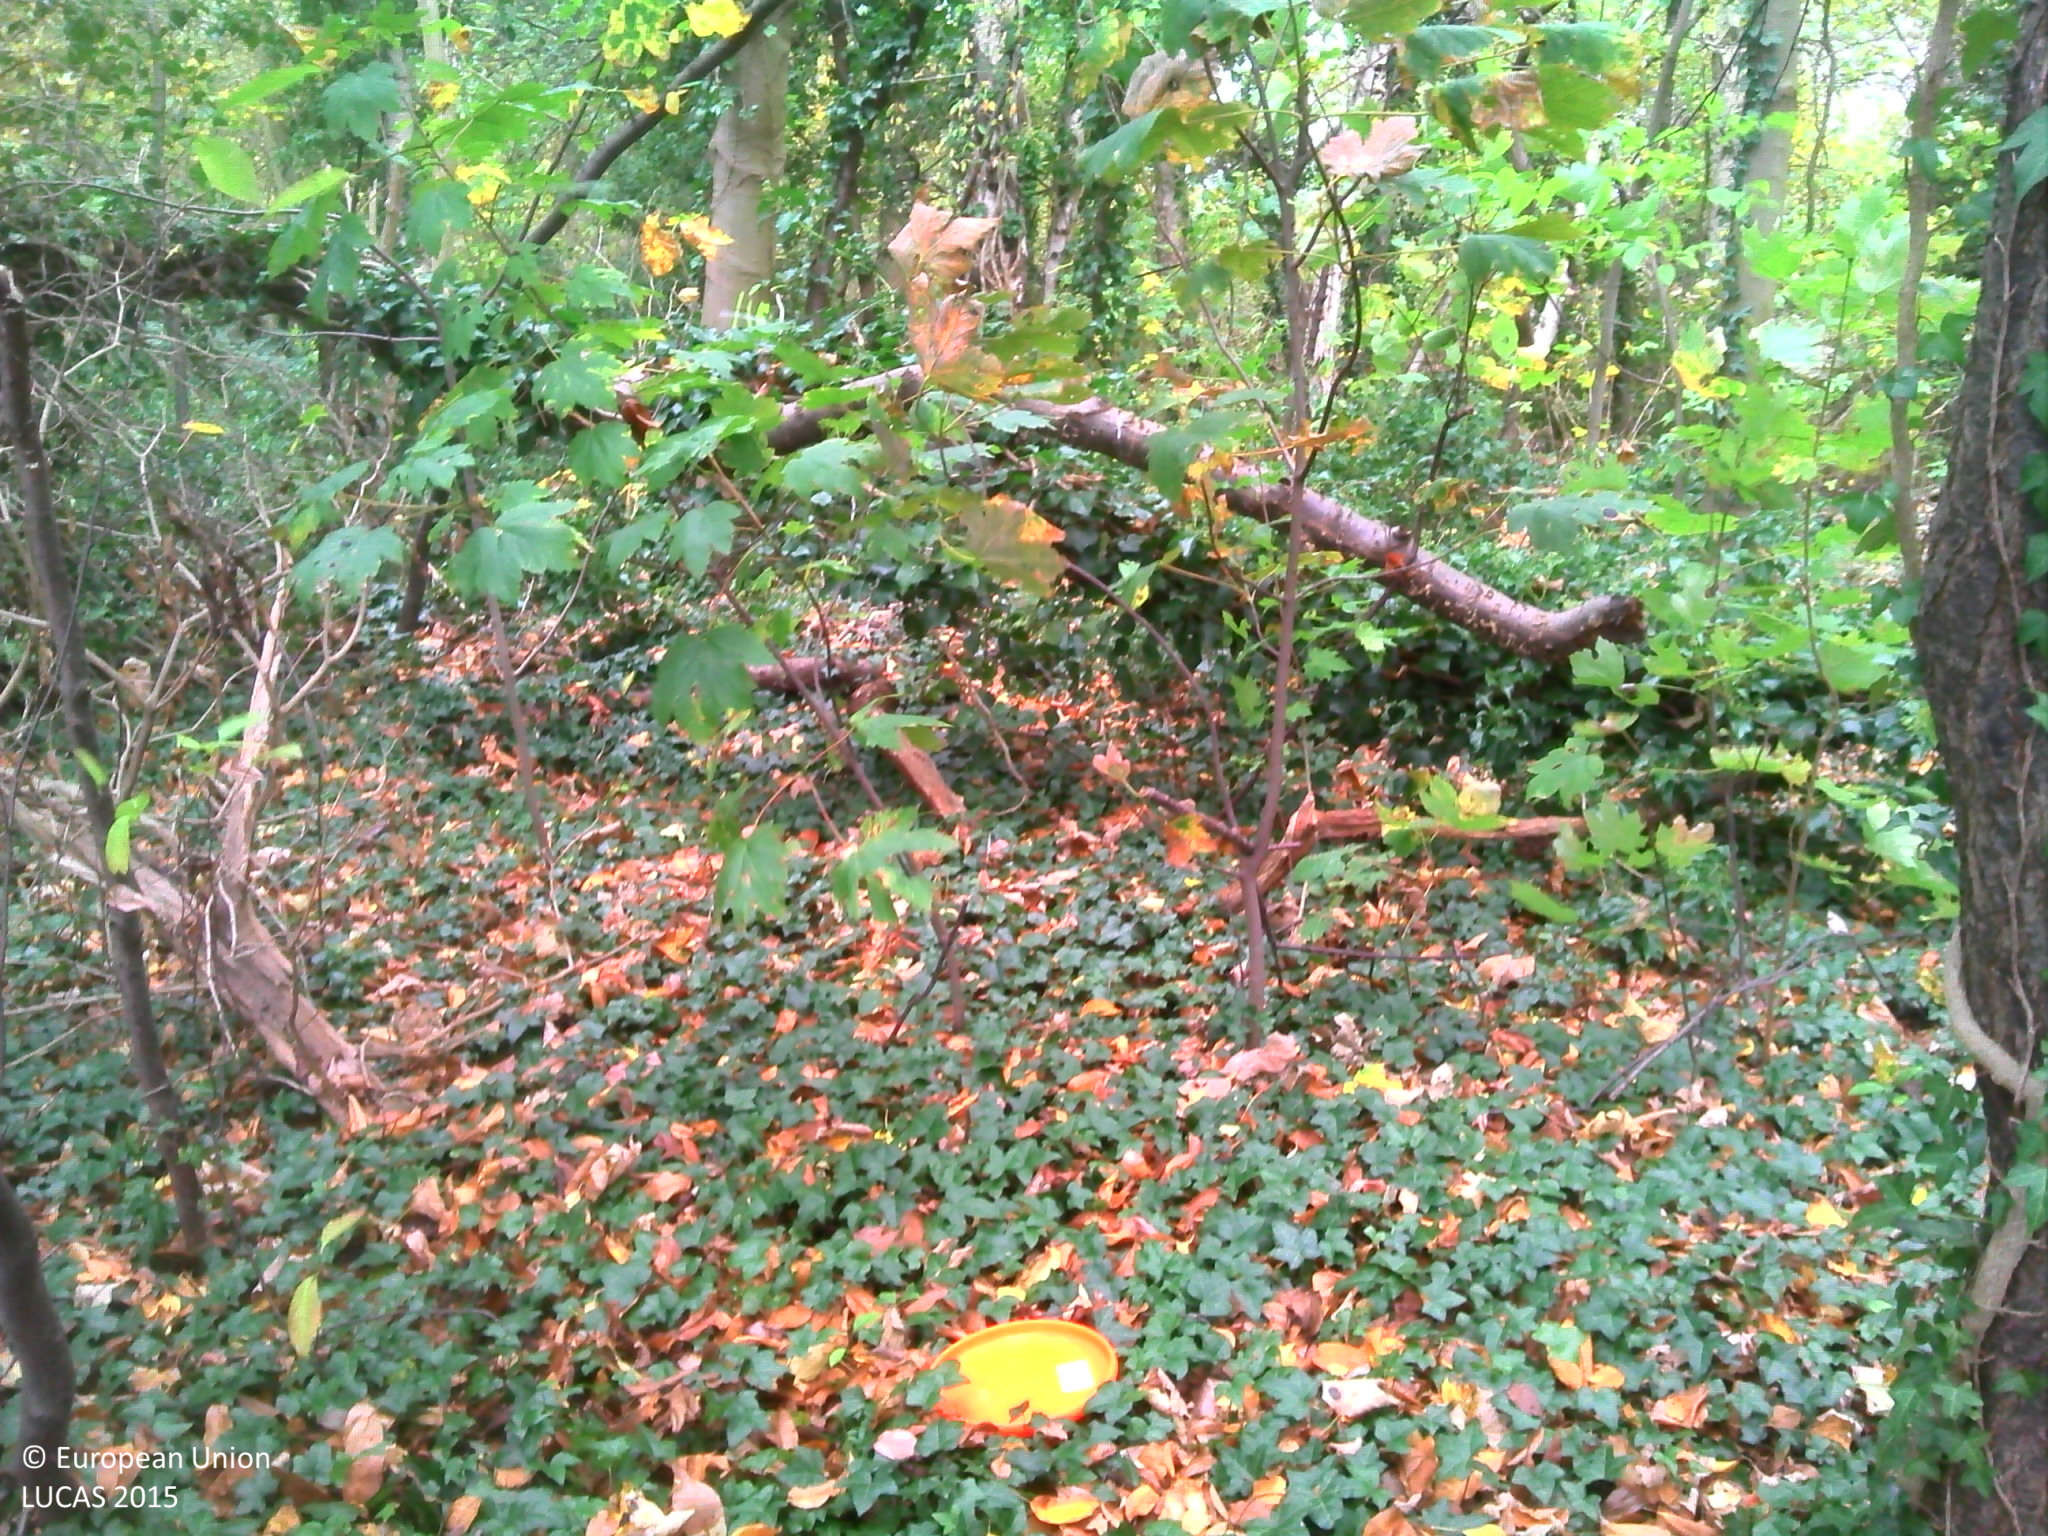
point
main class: Woodland
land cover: Broadleaved woodland
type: mesophytic deciduous forest
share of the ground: > 75 %
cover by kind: broadleaved forest trees 95 %, herbaceous plants 5 %
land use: Forestry
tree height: > 5 m
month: November
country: BE
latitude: 51.0071
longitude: 4.5088
